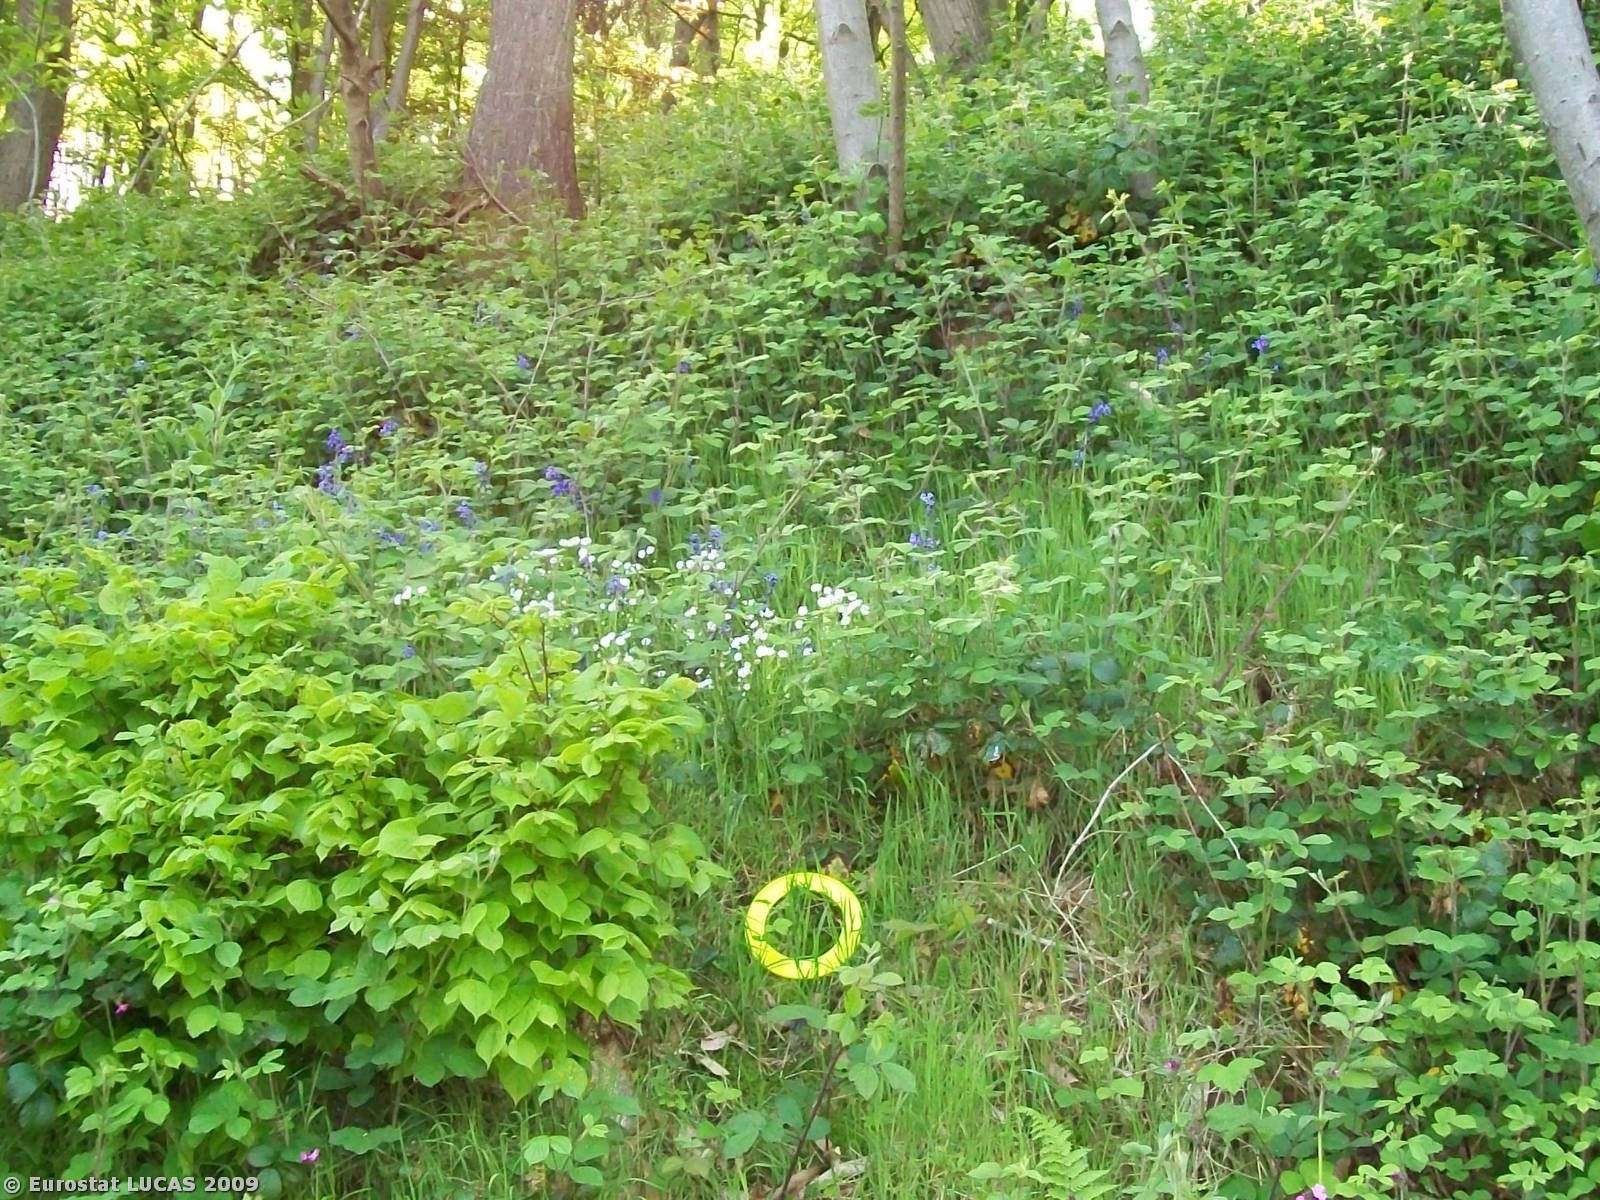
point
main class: Cropland
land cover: Maize
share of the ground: < 10 %
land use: Agriculture (excluding fallow land and kitchen gardens)
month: May
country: GB
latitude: 52.3505
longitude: -2.5011
